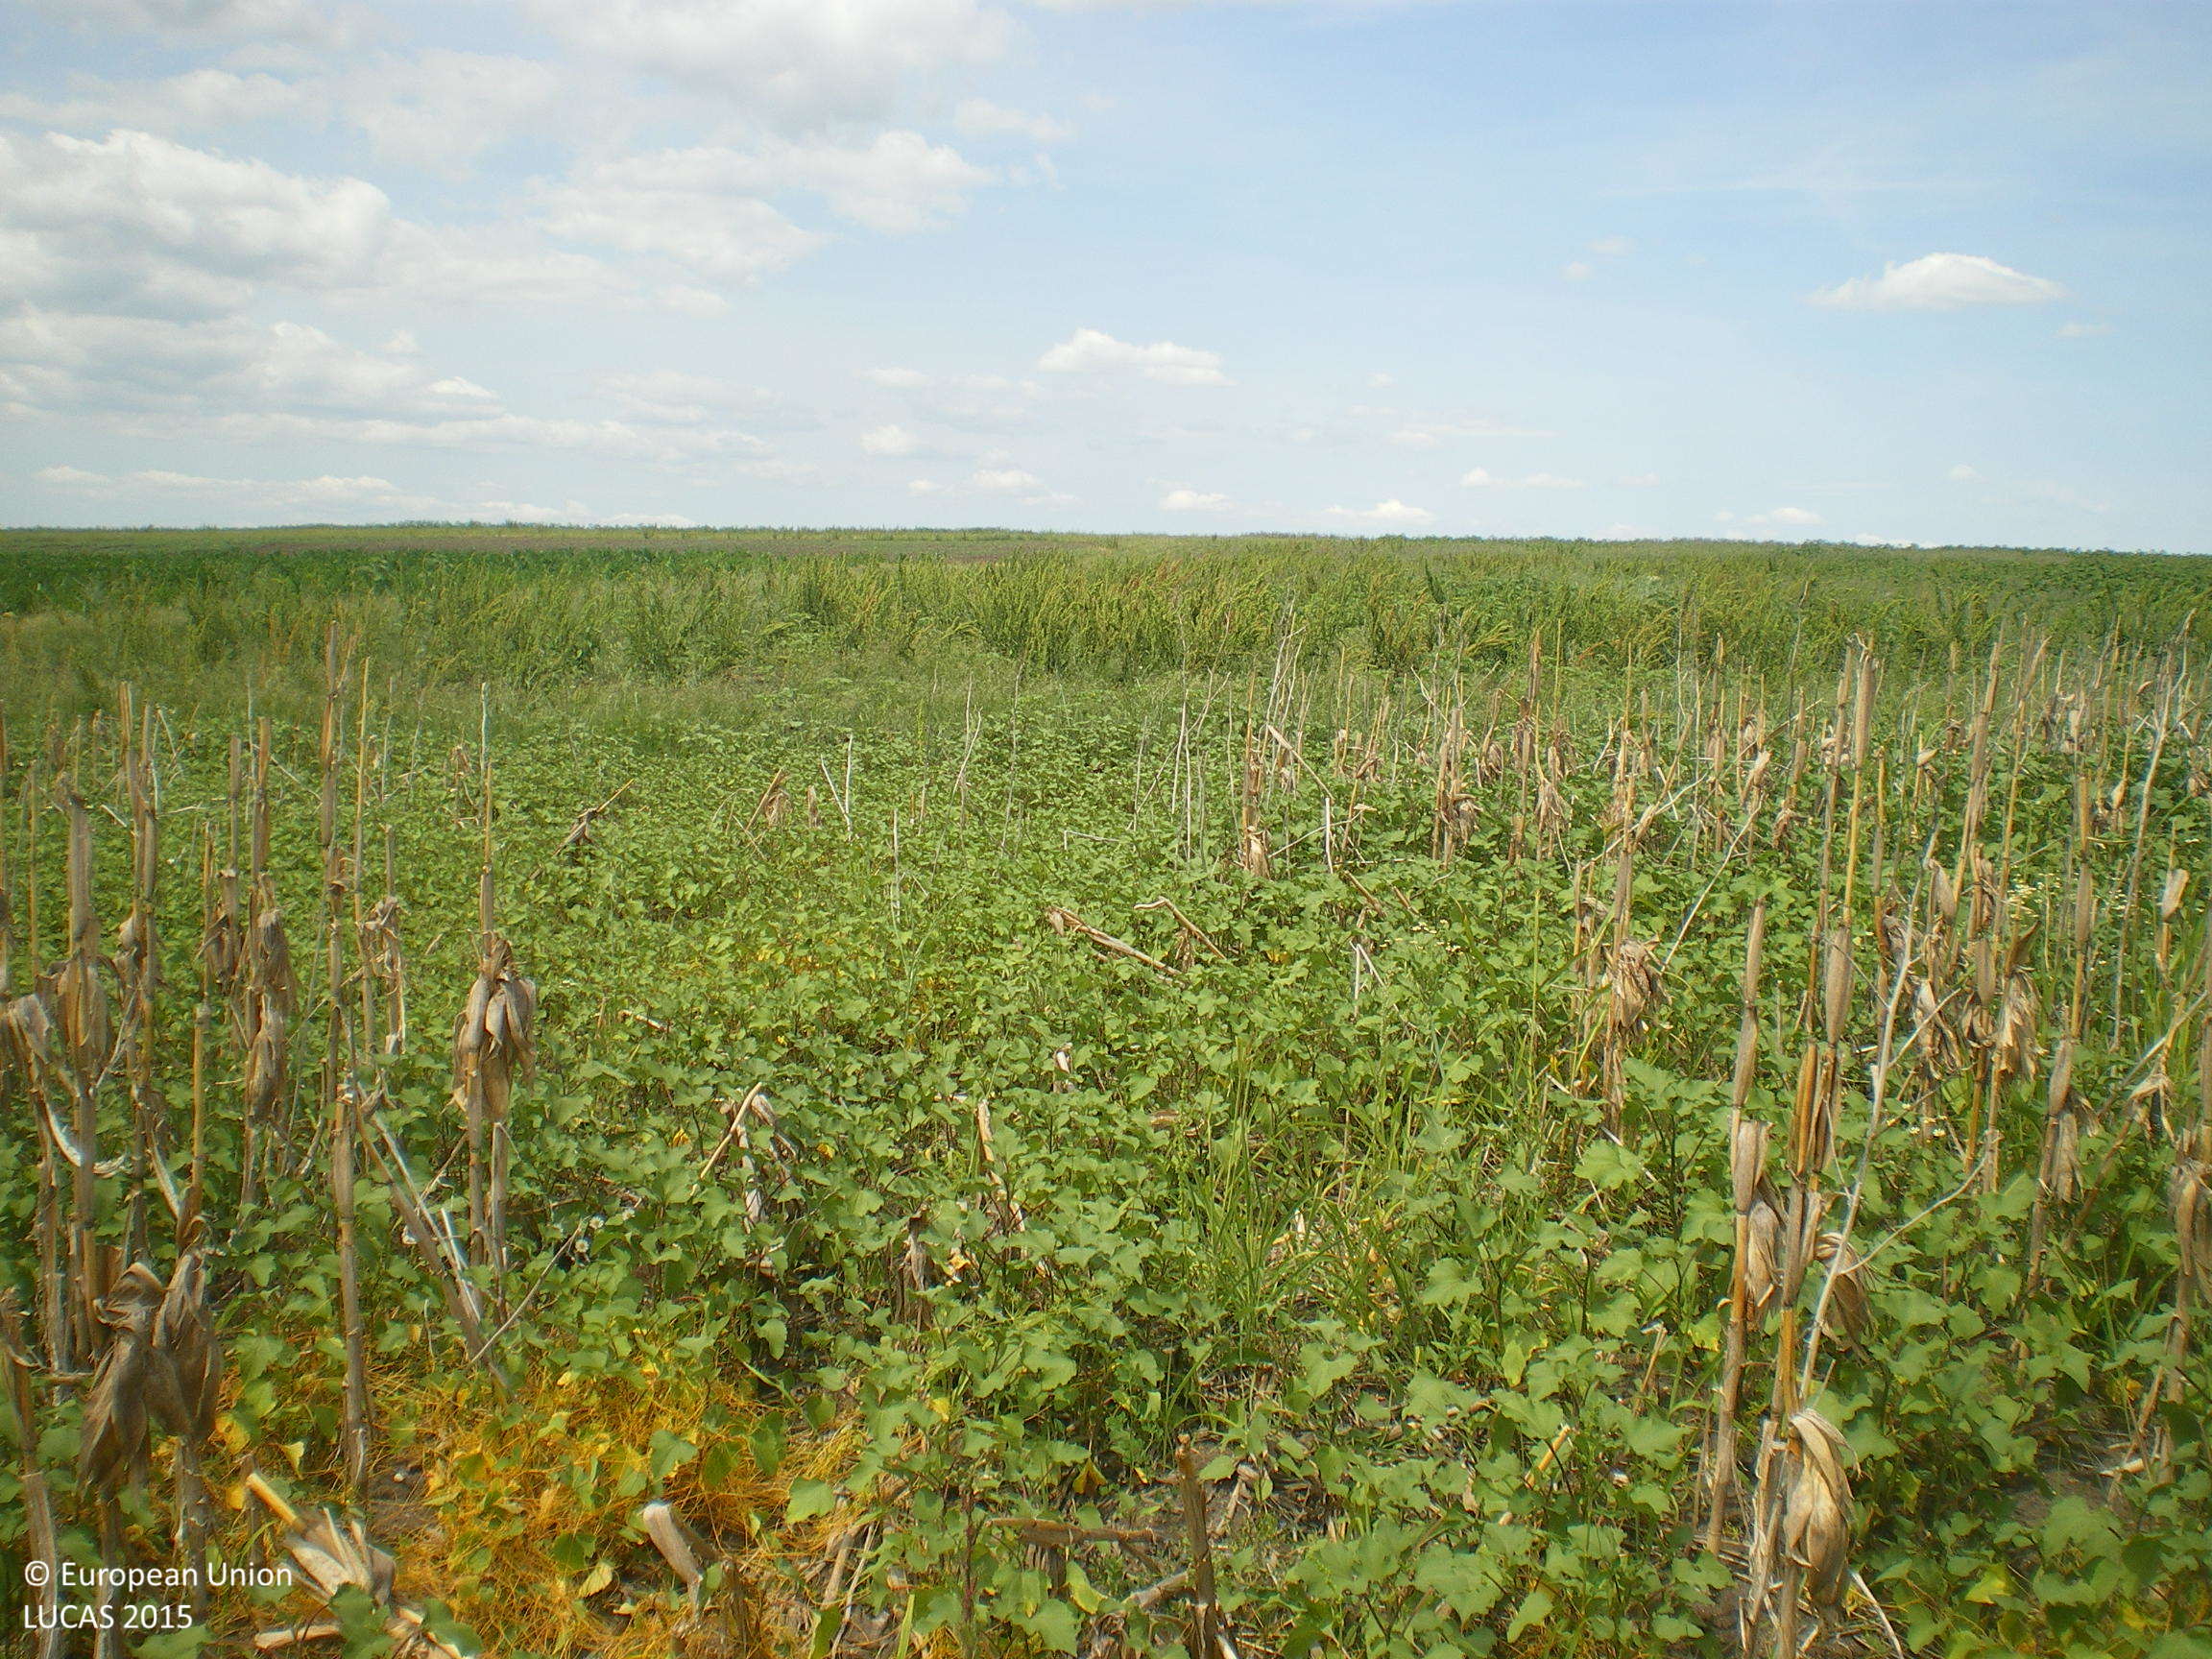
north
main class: Grassland
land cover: Spontaneously vegetated surfaces
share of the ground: > 75 %
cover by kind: herbaceous plants 85 %, unconsolidated bare surface 15 %
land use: Fallow land
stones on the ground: < 10 %
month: June
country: BG
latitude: 42.0096
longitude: 25.4584
